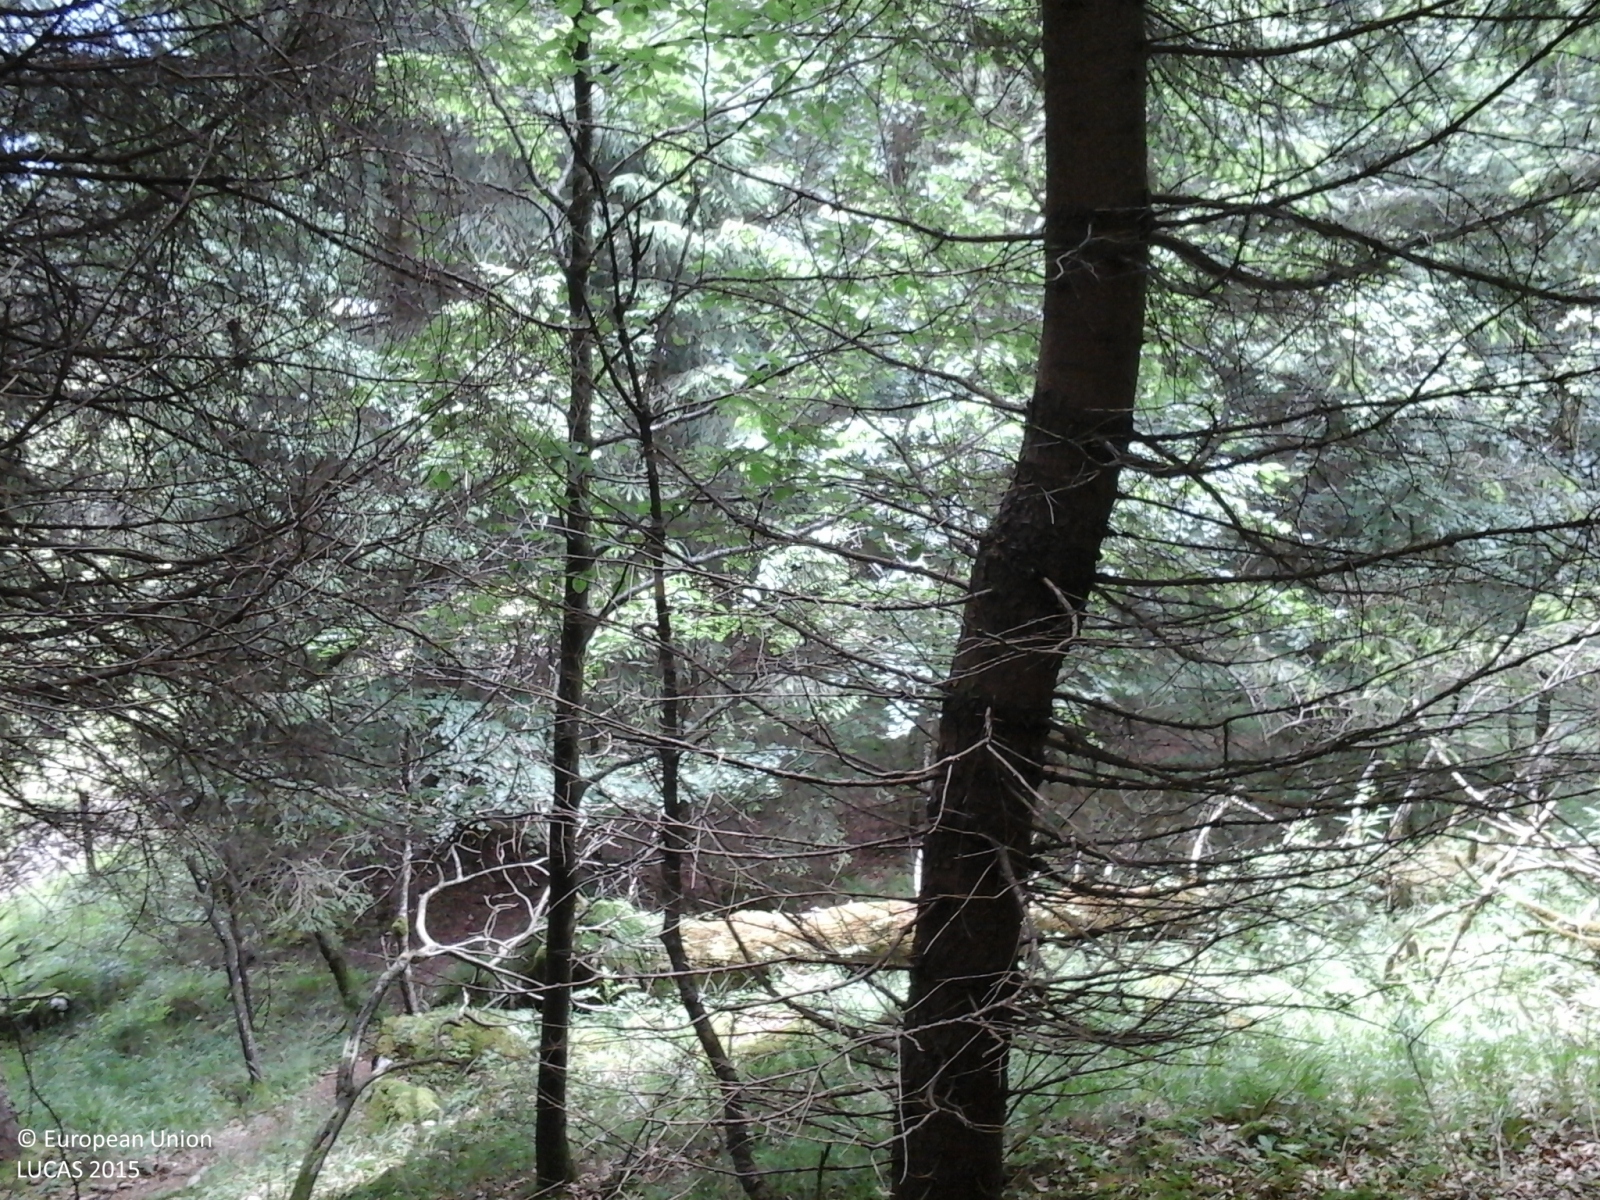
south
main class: Woodland
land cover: Spruce dominated mixed woodland
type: alpine coniferous forest
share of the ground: > 75 %
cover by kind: coniferous forest trees 75 %, broadleaved forest trees 25 %
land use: Semi-natural and natural areas not in use
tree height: > 5 m
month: June
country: IT
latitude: 46.0897
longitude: 12.4155
